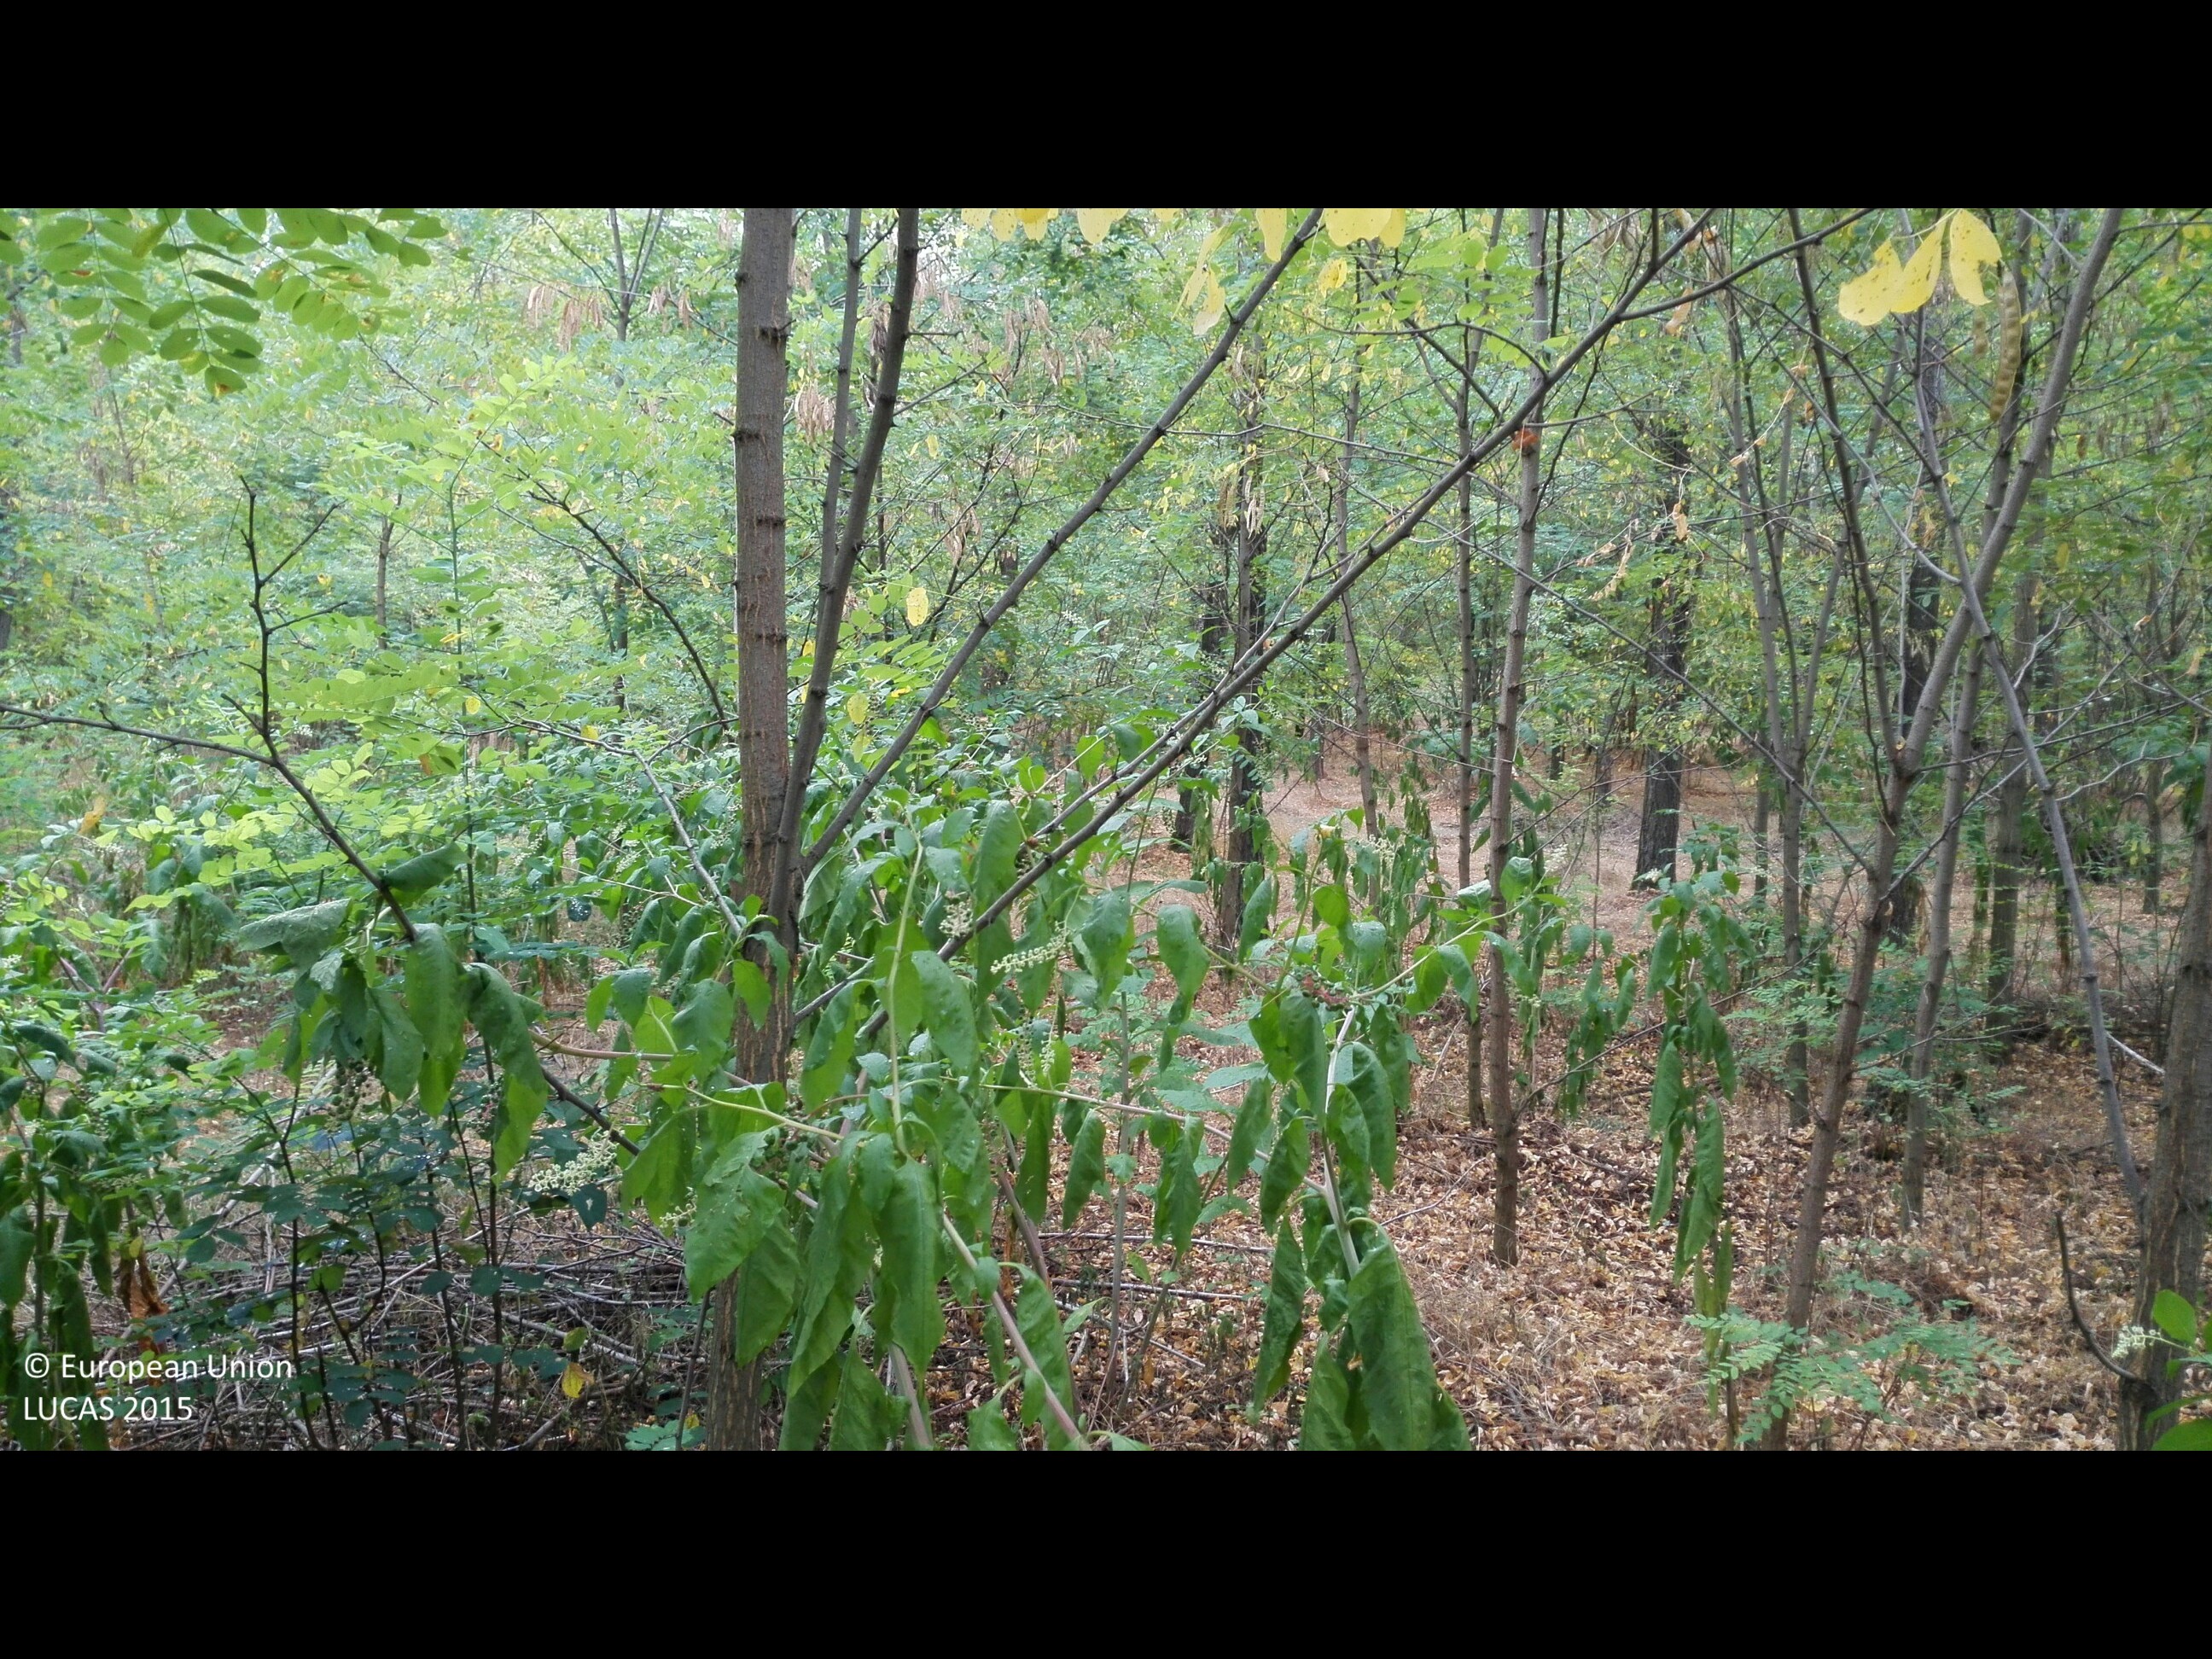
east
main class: Woodland
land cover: Broadleaved woodland
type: exotic forest
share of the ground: > 75 %
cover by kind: broadleaved forest trees 90 %, shrubs 5 %, herbaceous plants 5 %
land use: Forestry
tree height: > 5 m
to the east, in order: Broadleaved woodland; Grassland with sparse tree/shrub cover; Railways; Broadleaved woodland
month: August
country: HU
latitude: 47.7269
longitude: 21.6857
